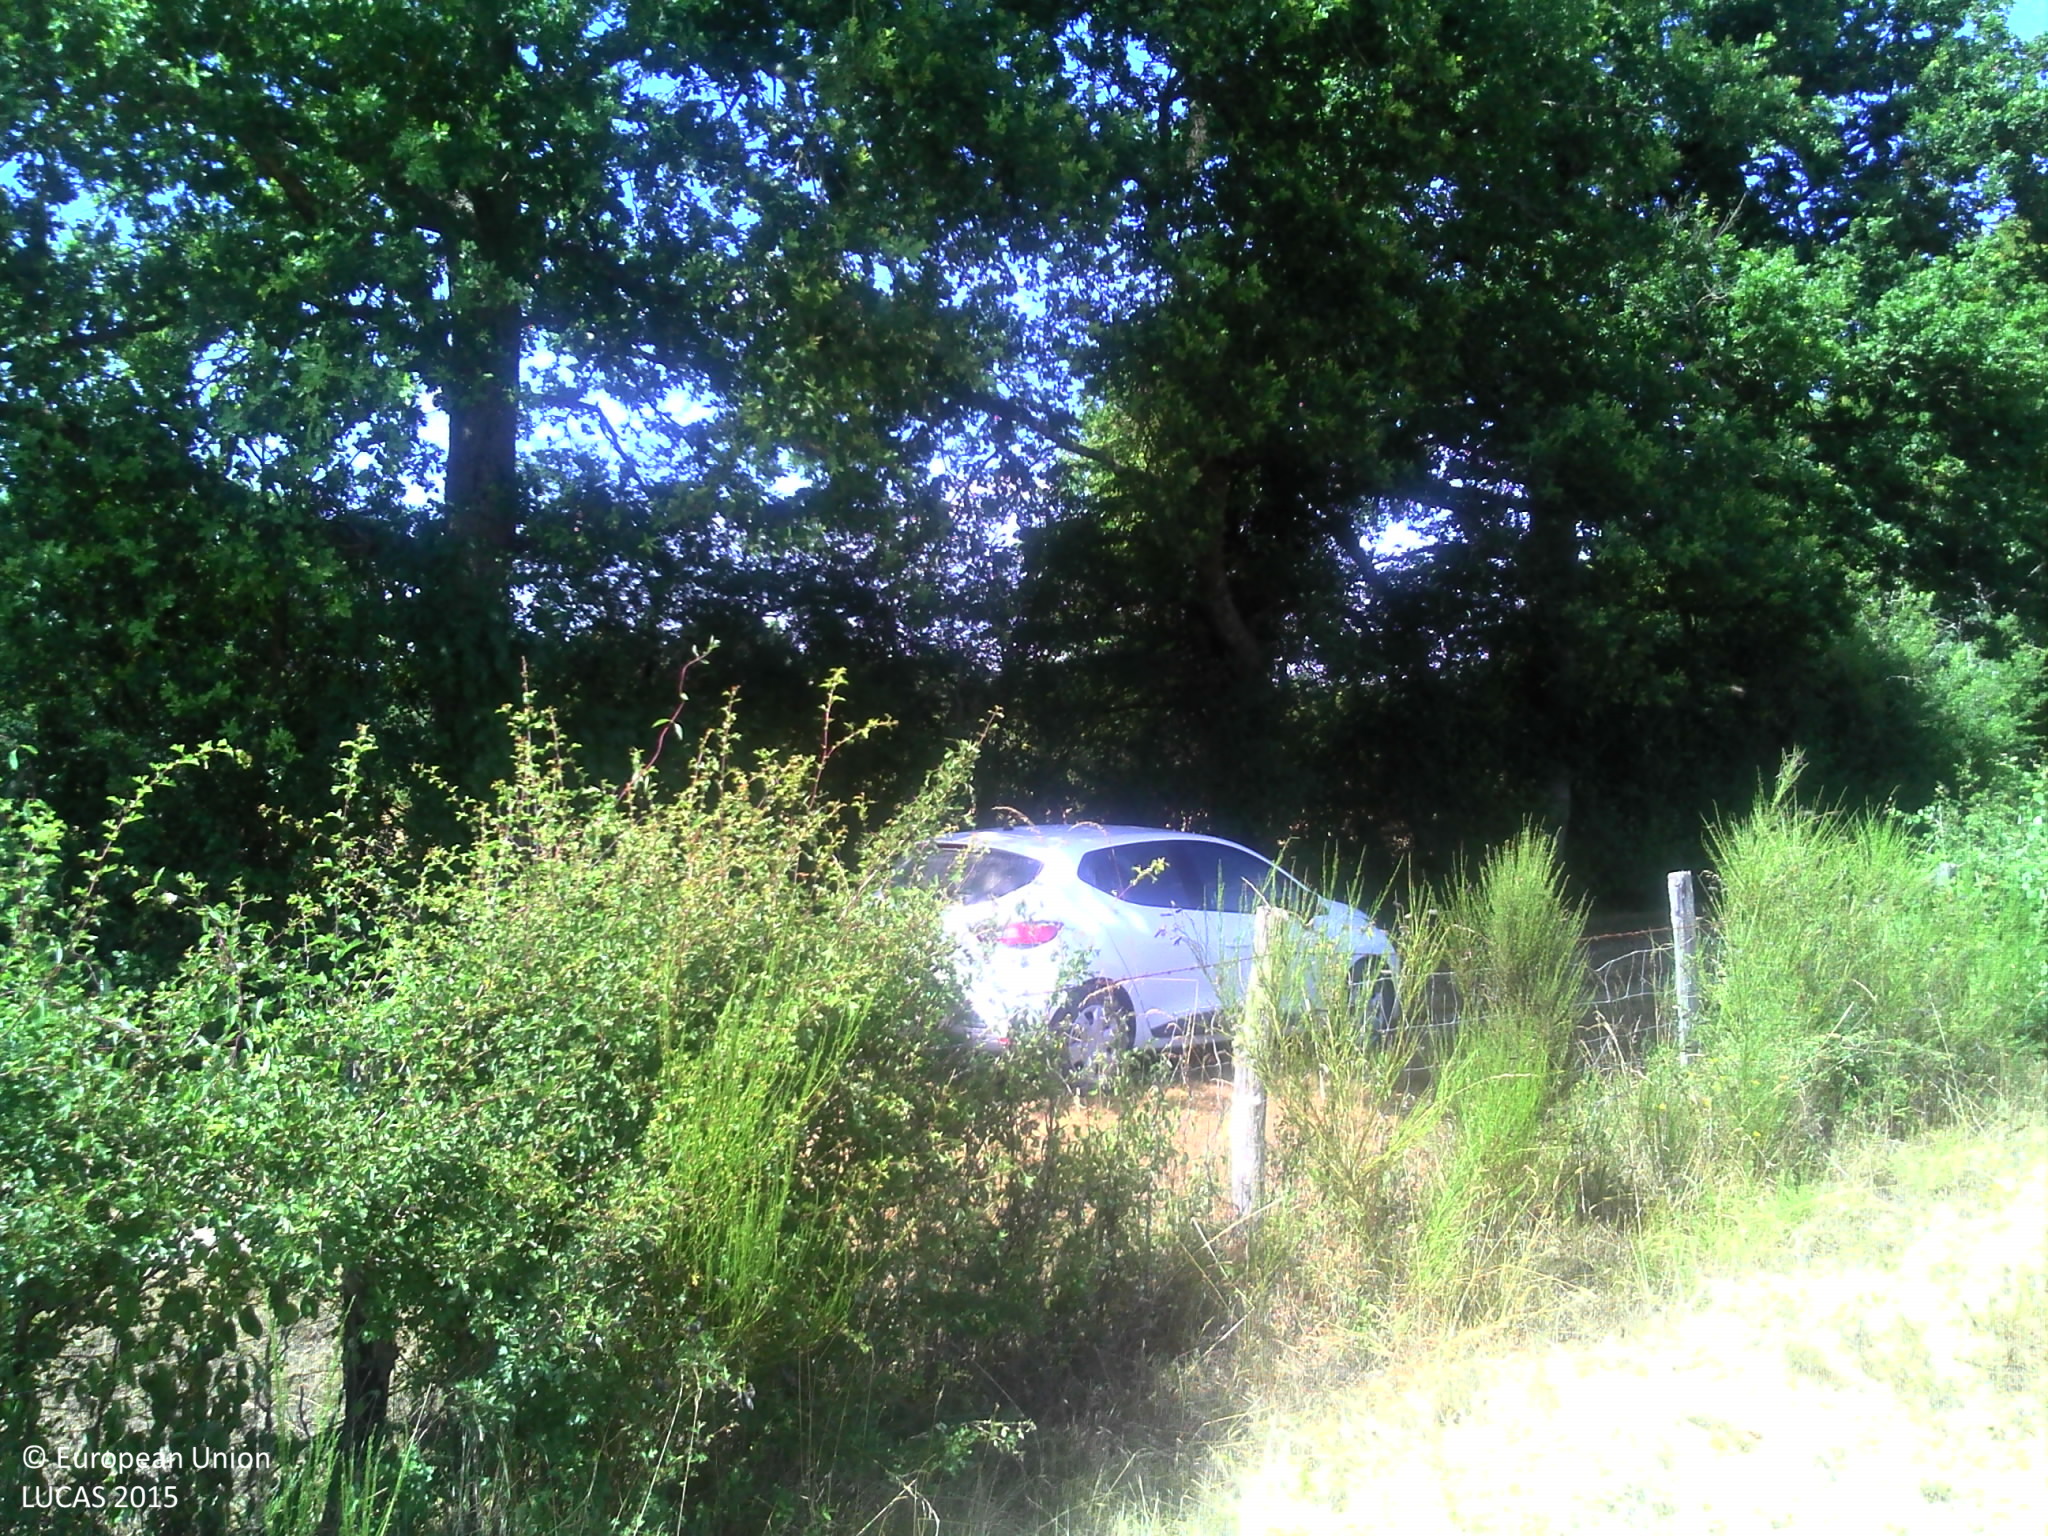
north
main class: Grassland
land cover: Grassland without tree/shrub cover
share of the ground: > 75 %
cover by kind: herbaceous plants 100 %
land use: Agriculture (excluding fallow land and kitchen gardens)
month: June
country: FR
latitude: 47.7713
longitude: 2.5321
